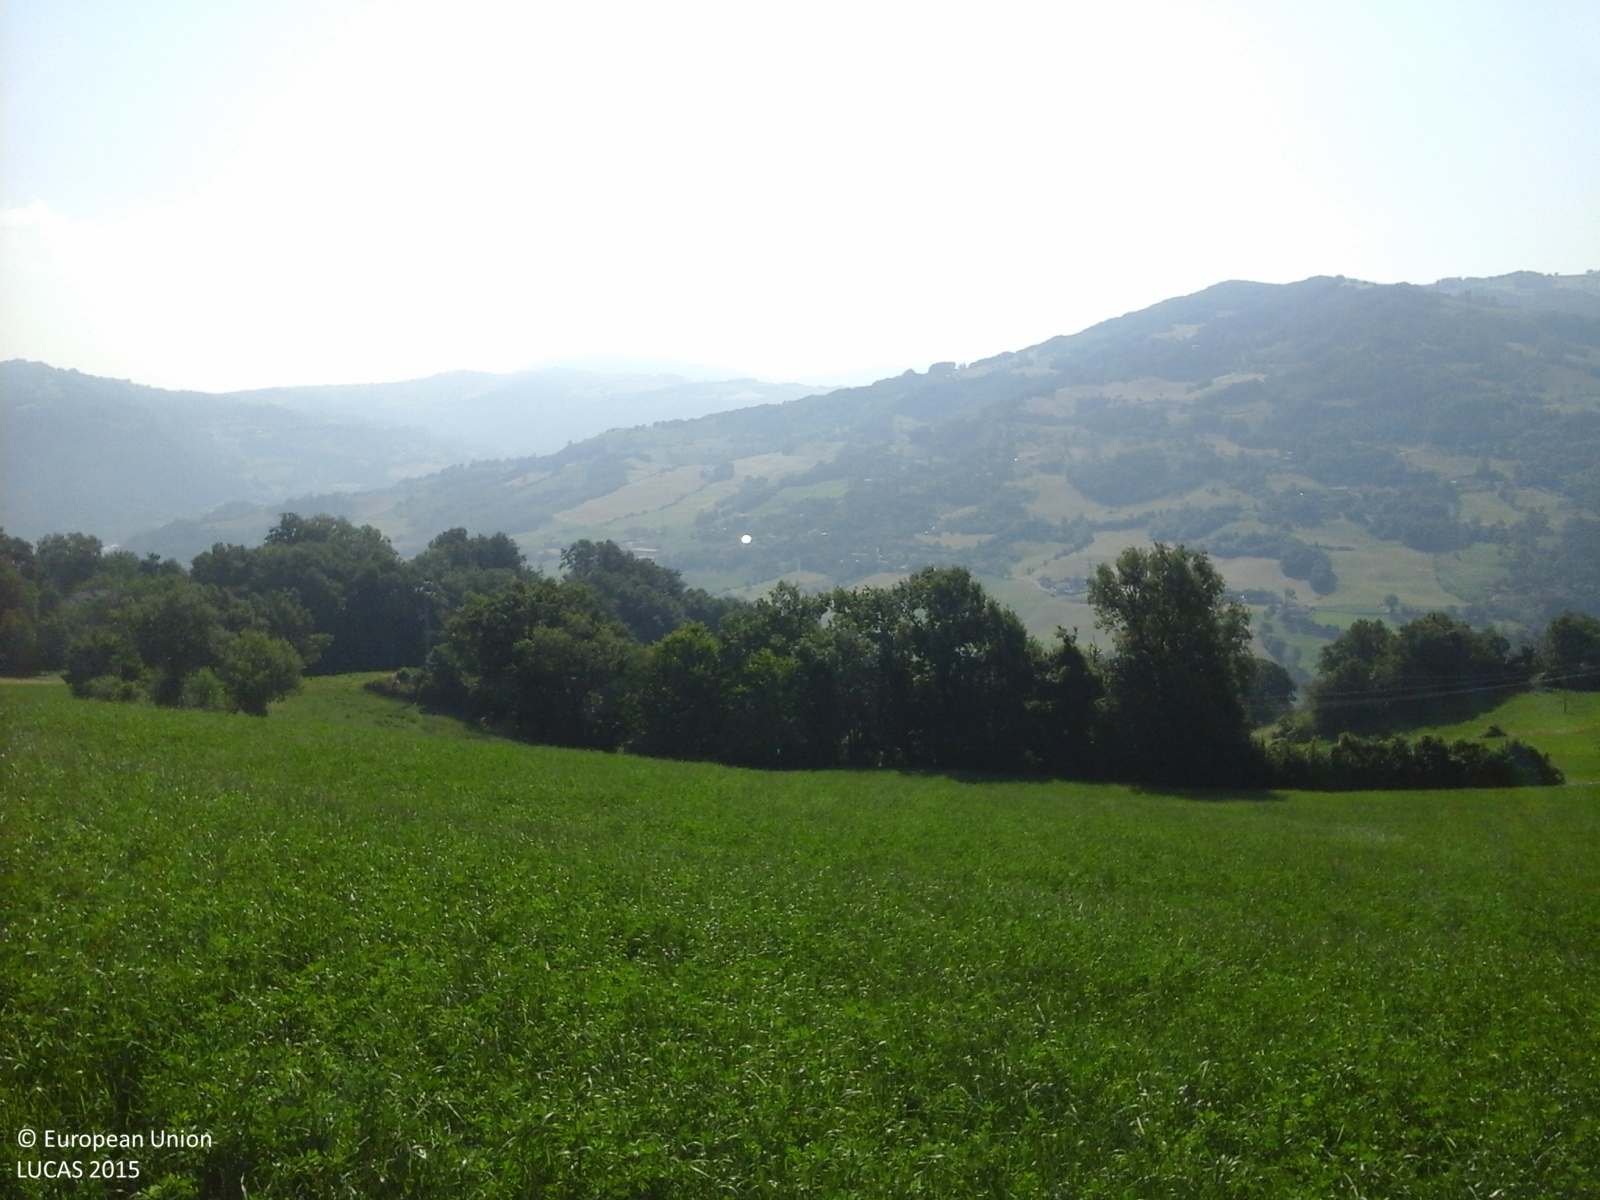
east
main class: Cropland
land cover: Lucerne
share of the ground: > 75 %
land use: Agriculture (excluding fallow land and kitchen gardens)
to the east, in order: Lucerne; Managed hedges; Paved roads, cycling and walking lanes; Lucerne; Electric lines; Lucerne; Broadleaved woodland; Spontaneously vegetated surfaces
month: June
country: IT
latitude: 44.4209
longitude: 10.6140
